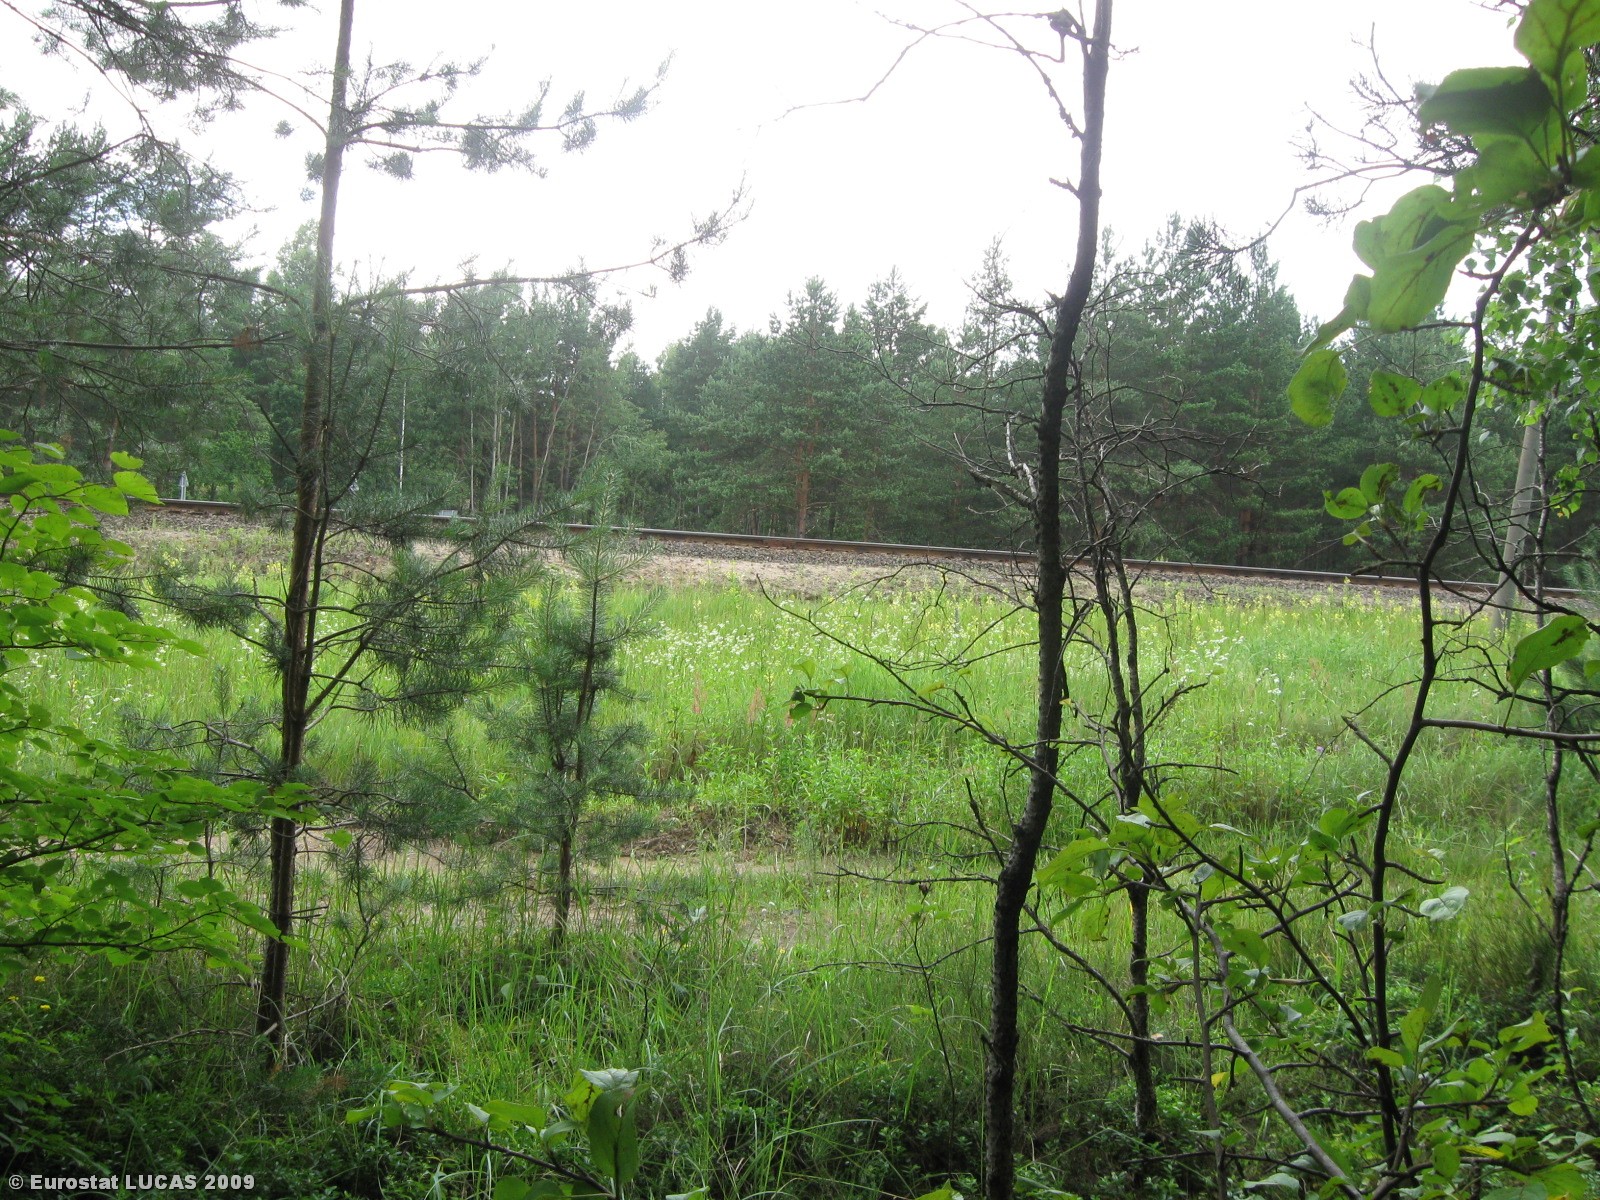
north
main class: Woodland
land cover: Mixed woodland
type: hemiboreal forest and nemoral coniferous forest and mixed broadleaved-coniferous forest
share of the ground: > 75 %
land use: Forestry
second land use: Amenities, museums, leisure
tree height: > 5 m
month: July
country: LT
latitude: 54.5874
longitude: 25.2708
